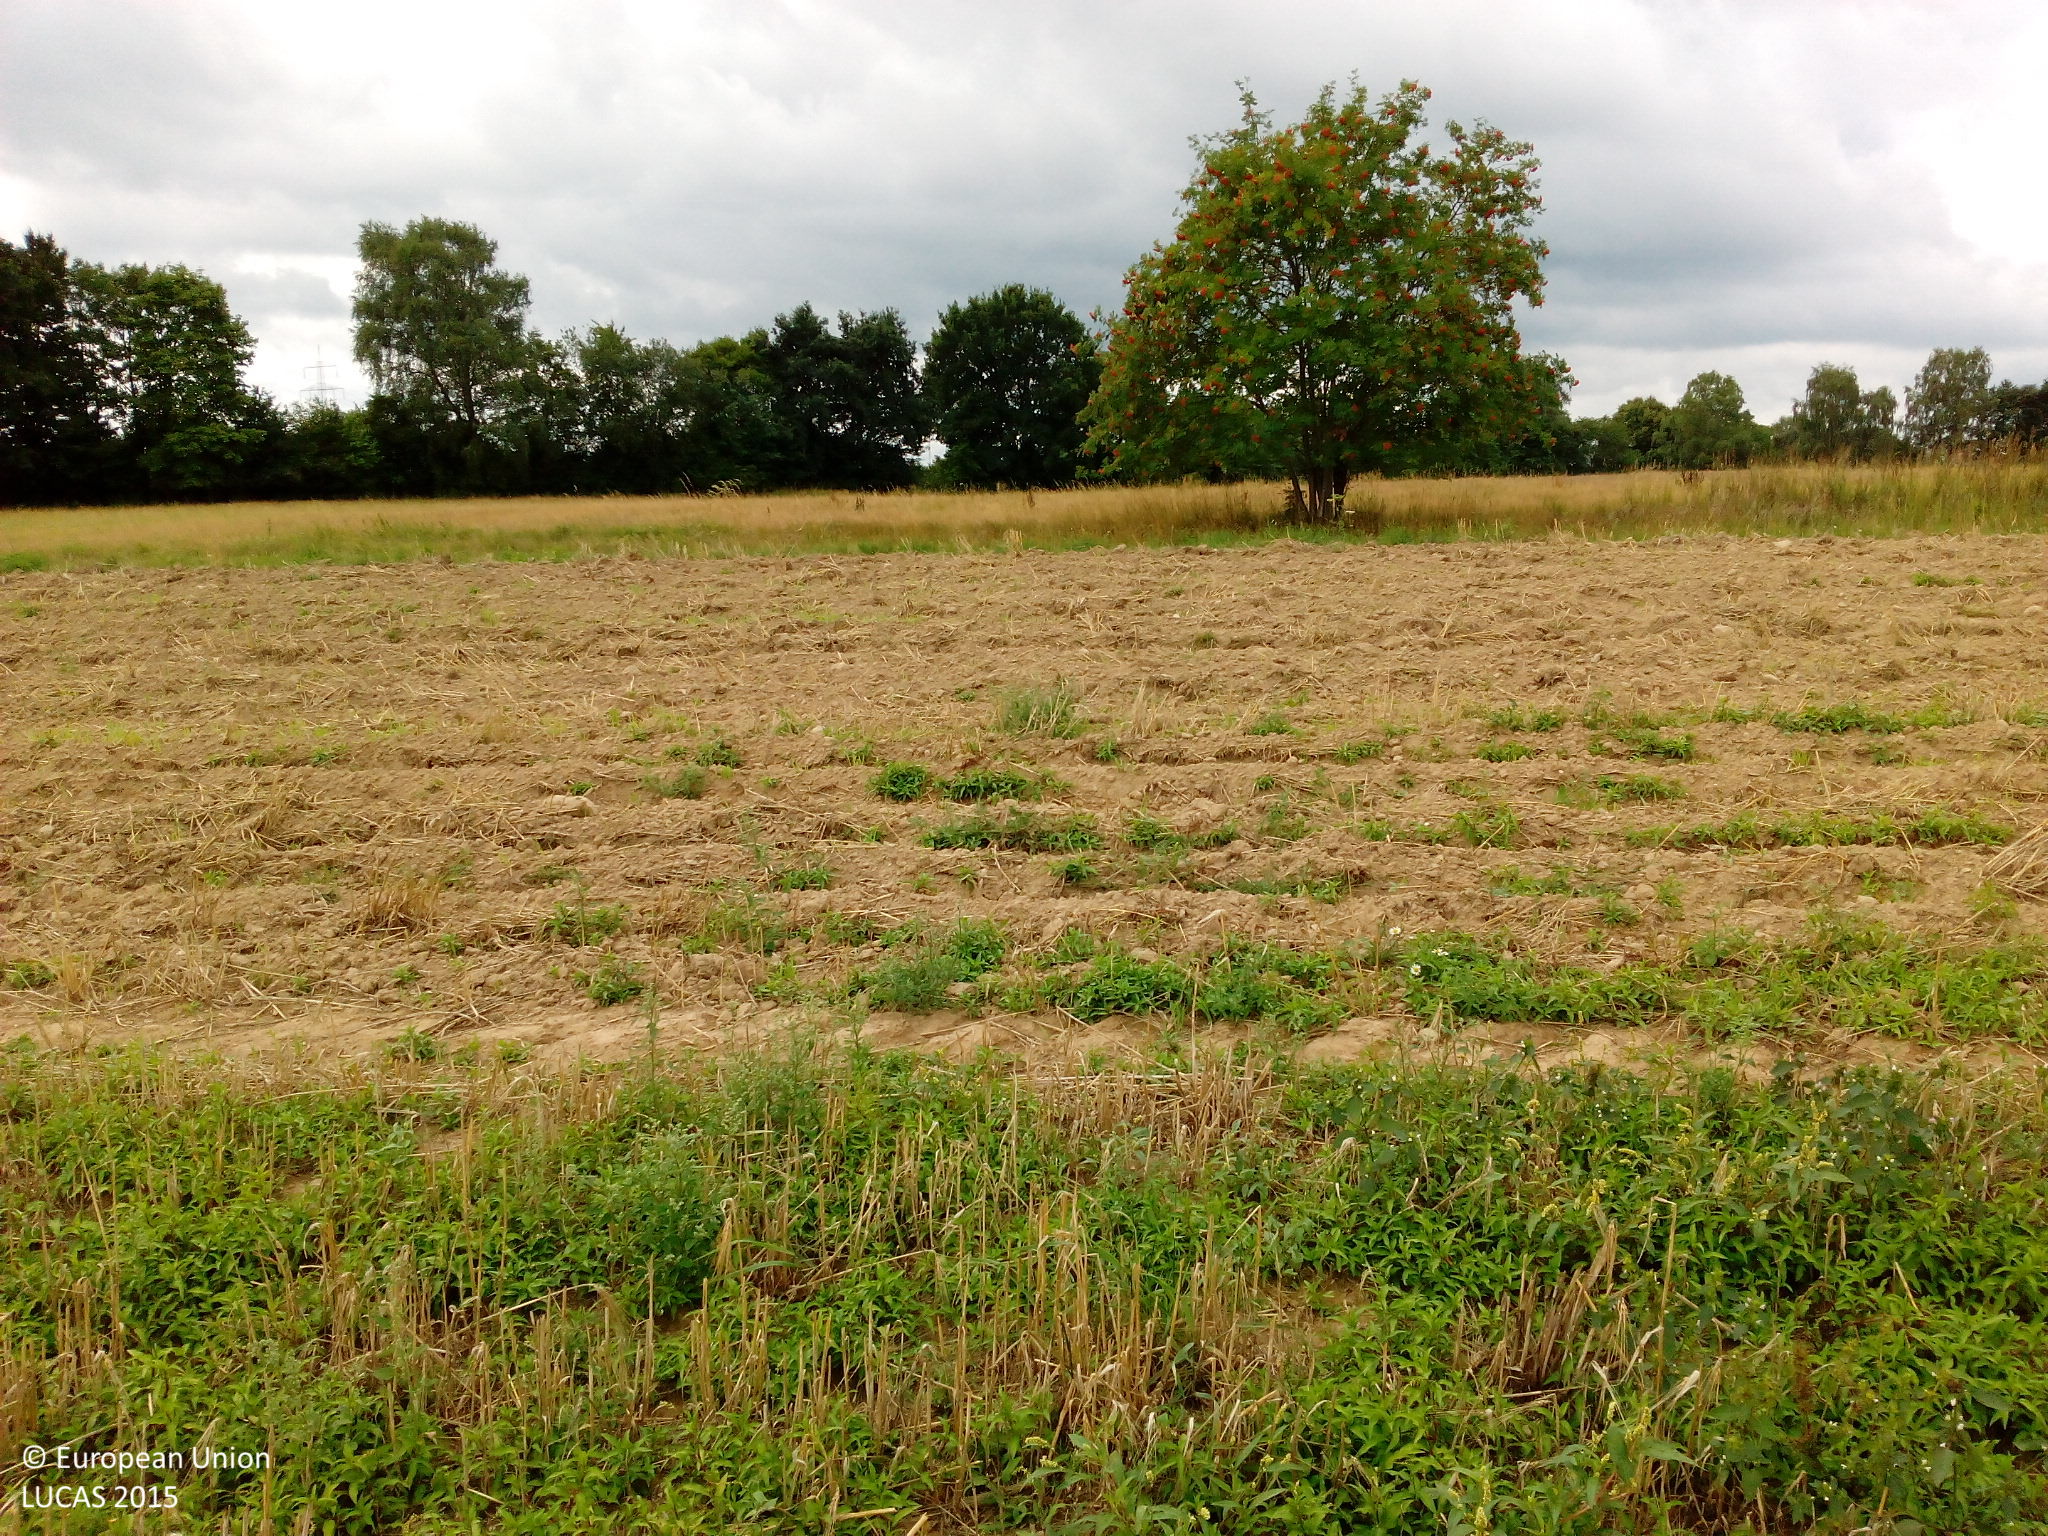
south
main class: Cropland
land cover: Triticale
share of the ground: > 75 %
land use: Agriculture (excluding fallow land and kitchen gardens)
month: July
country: DE
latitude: 50.4173
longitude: 9.5920
